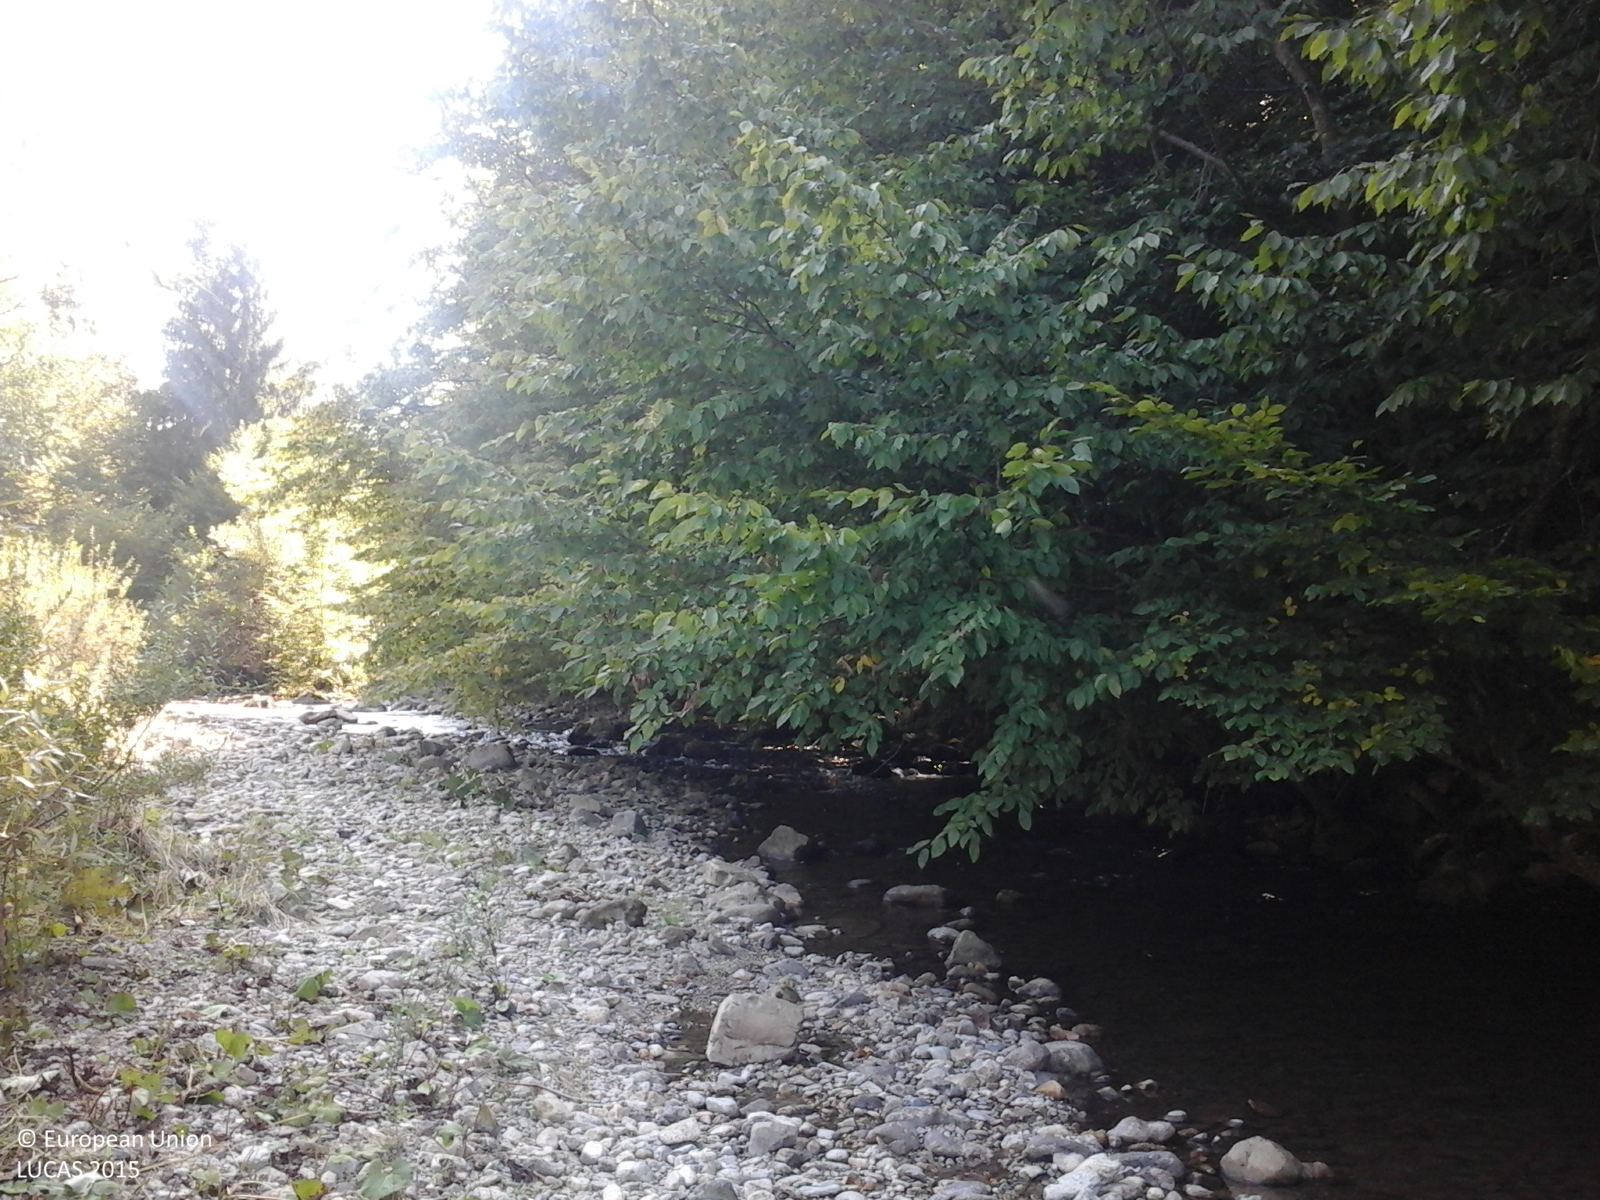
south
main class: Woodland
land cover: Other mixed woodland
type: acidophilous oak and oak-birch forest
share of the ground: > 75 %
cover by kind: broadleaved forest trees 75 %, coniferous forest trees 25 %
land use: Forestry
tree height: > 5 m
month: September
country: RO
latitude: 46.7556
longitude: 22.5563
